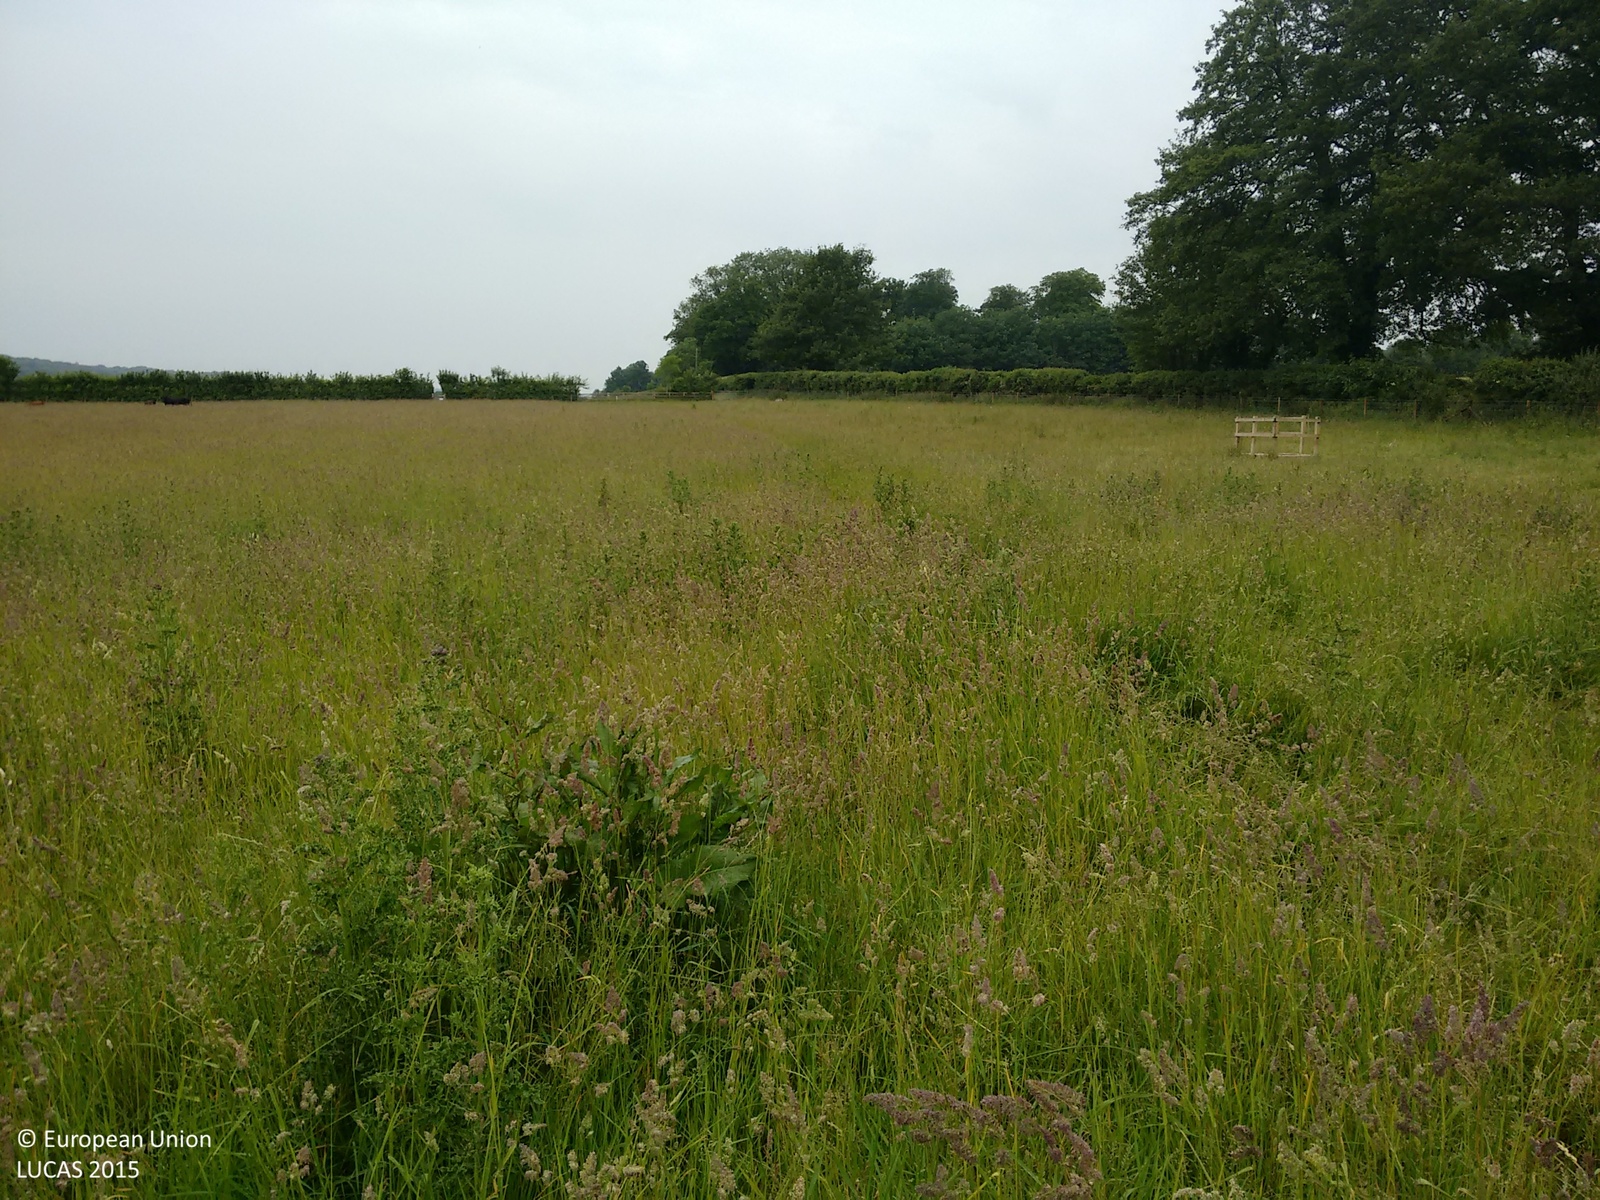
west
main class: Grassland
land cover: Grassland without tree/shrub cover
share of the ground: > 75 %
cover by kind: herbaceous plants 100 %
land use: Agriculture (excluding fallow land and kitchen gardens)
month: June
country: GB
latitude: 51.4518
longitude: -1.1412
